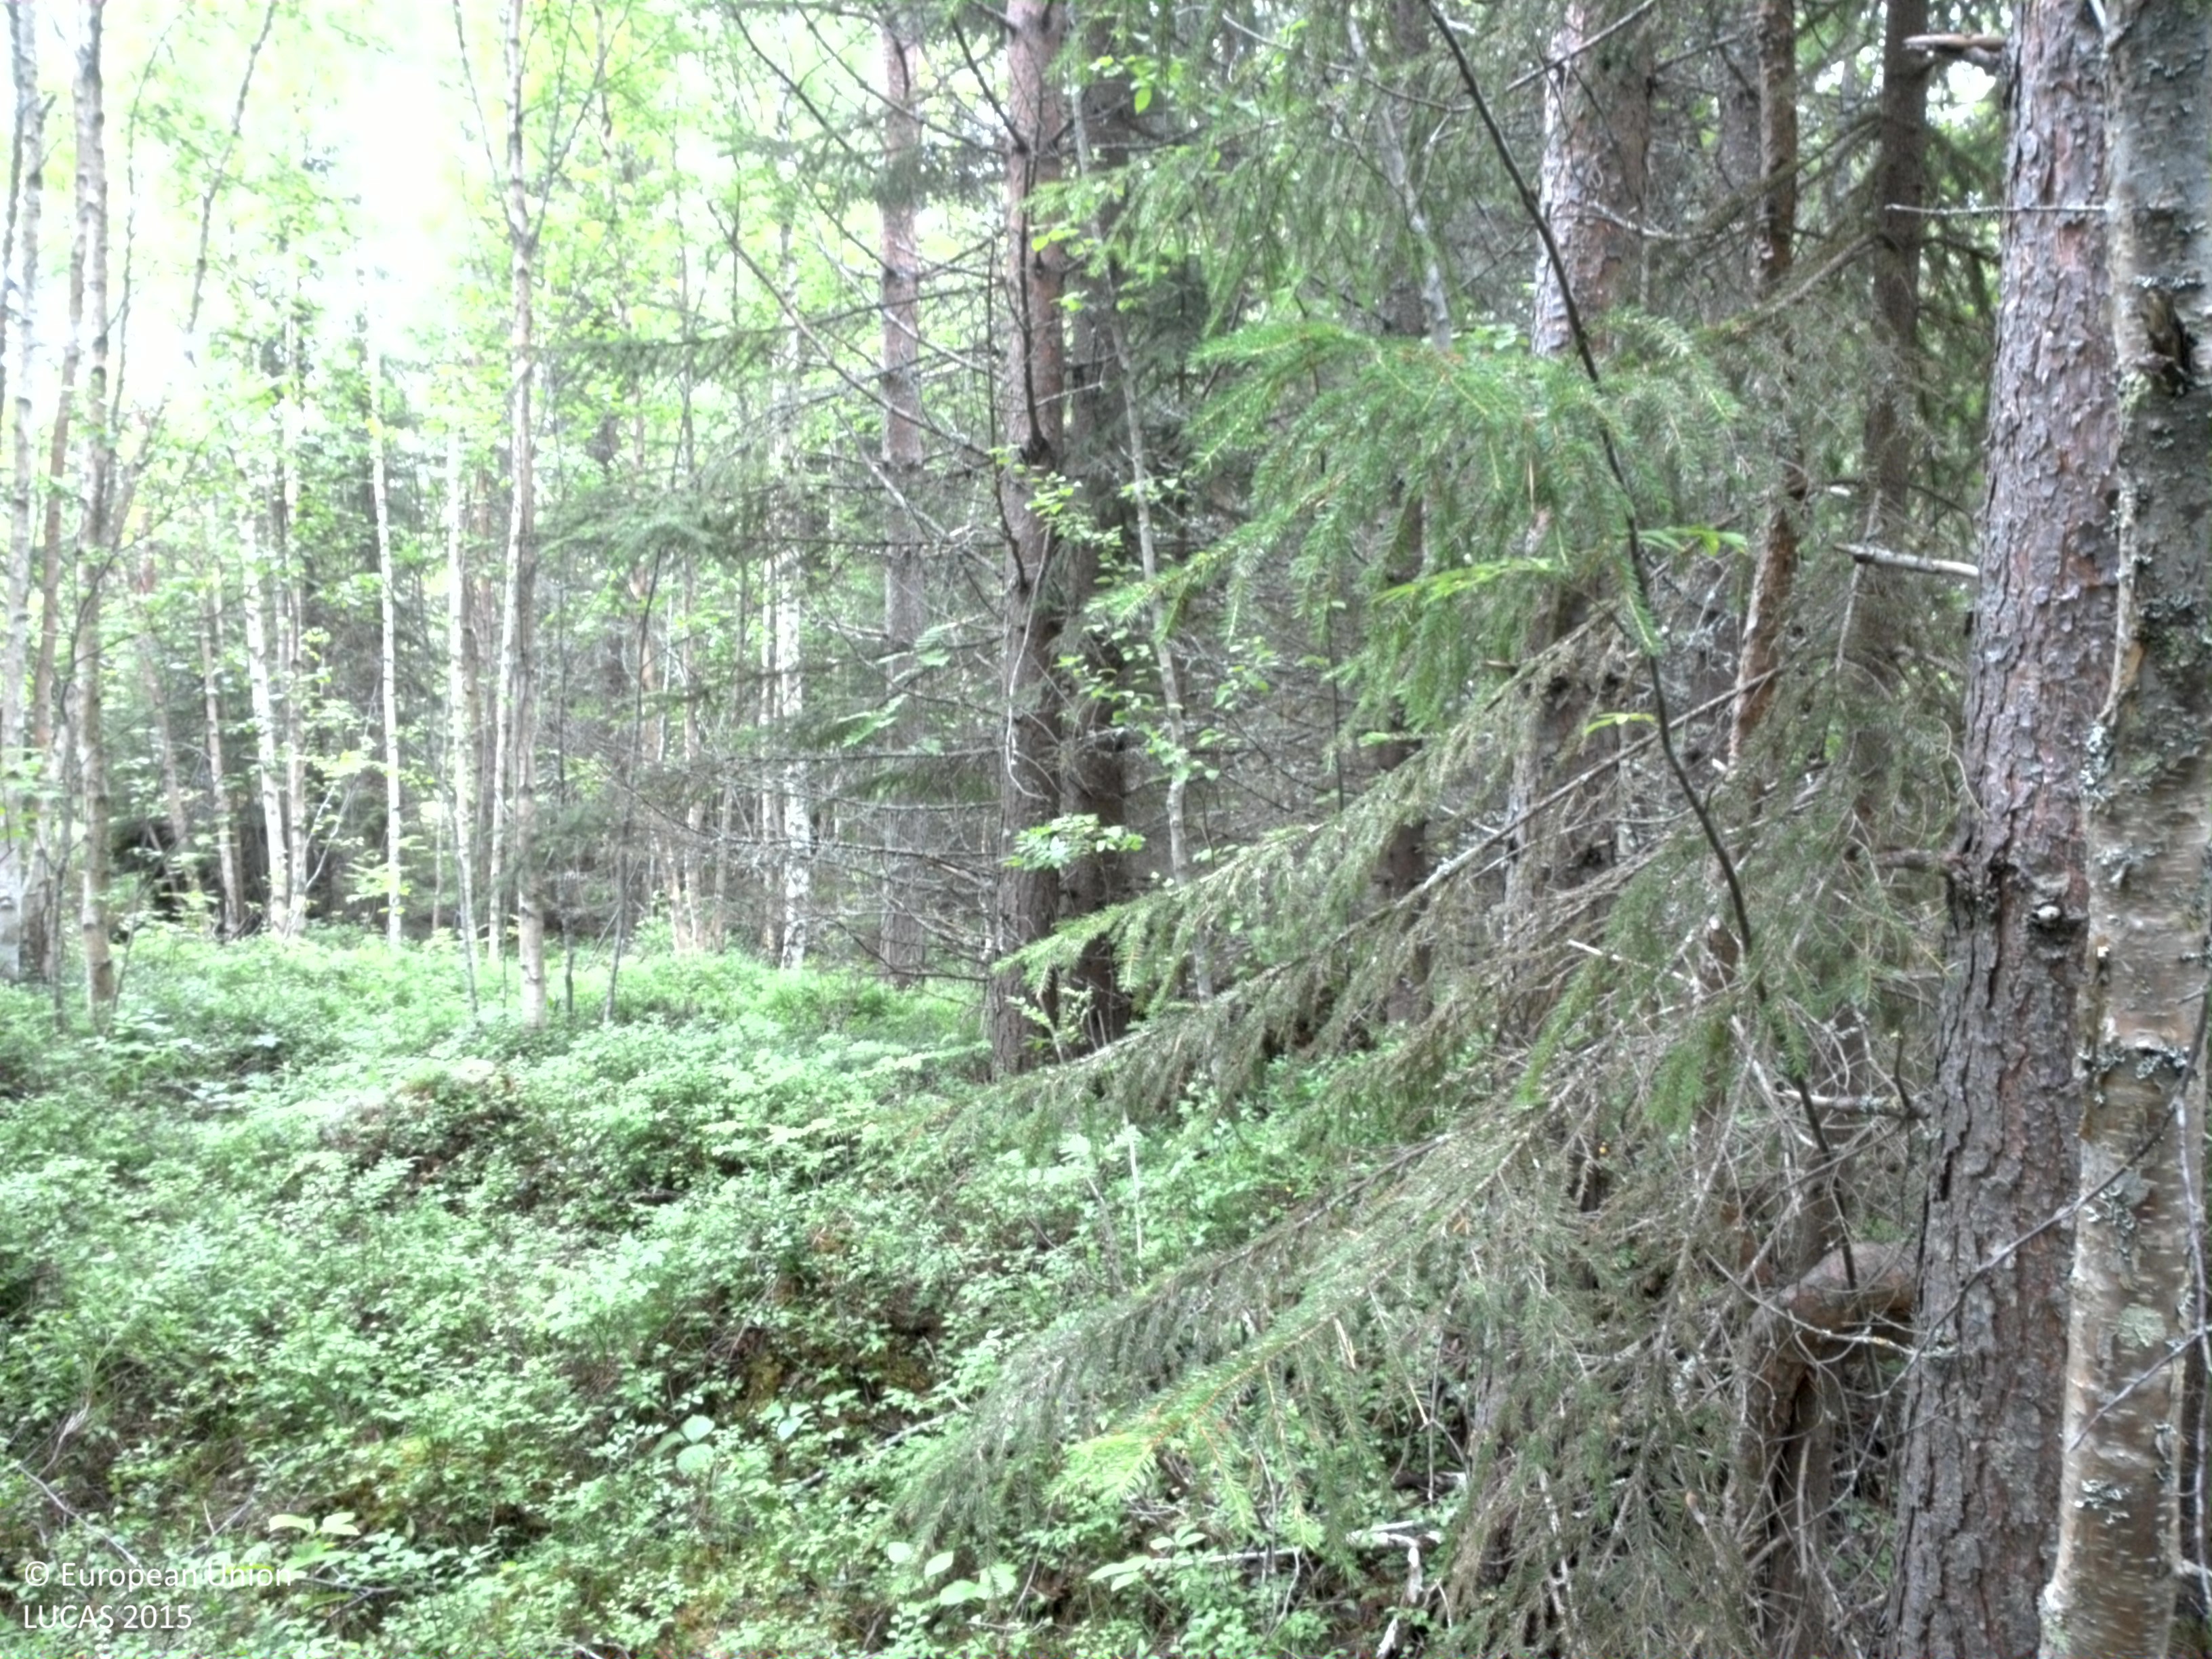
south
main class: Woodland
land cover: Spruce dominated mixed woodland
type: boreal forest
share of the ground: > 75 %
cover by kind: coniferous forest trees 60 %, broadleaved forest trees 20 %, shrubs 10 %, herbaceous plants 5 %, lichens and mosses 5 %
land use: Forestry
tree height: > 5 m
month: August
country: SE
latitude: 64.6619
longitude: 20.8894
